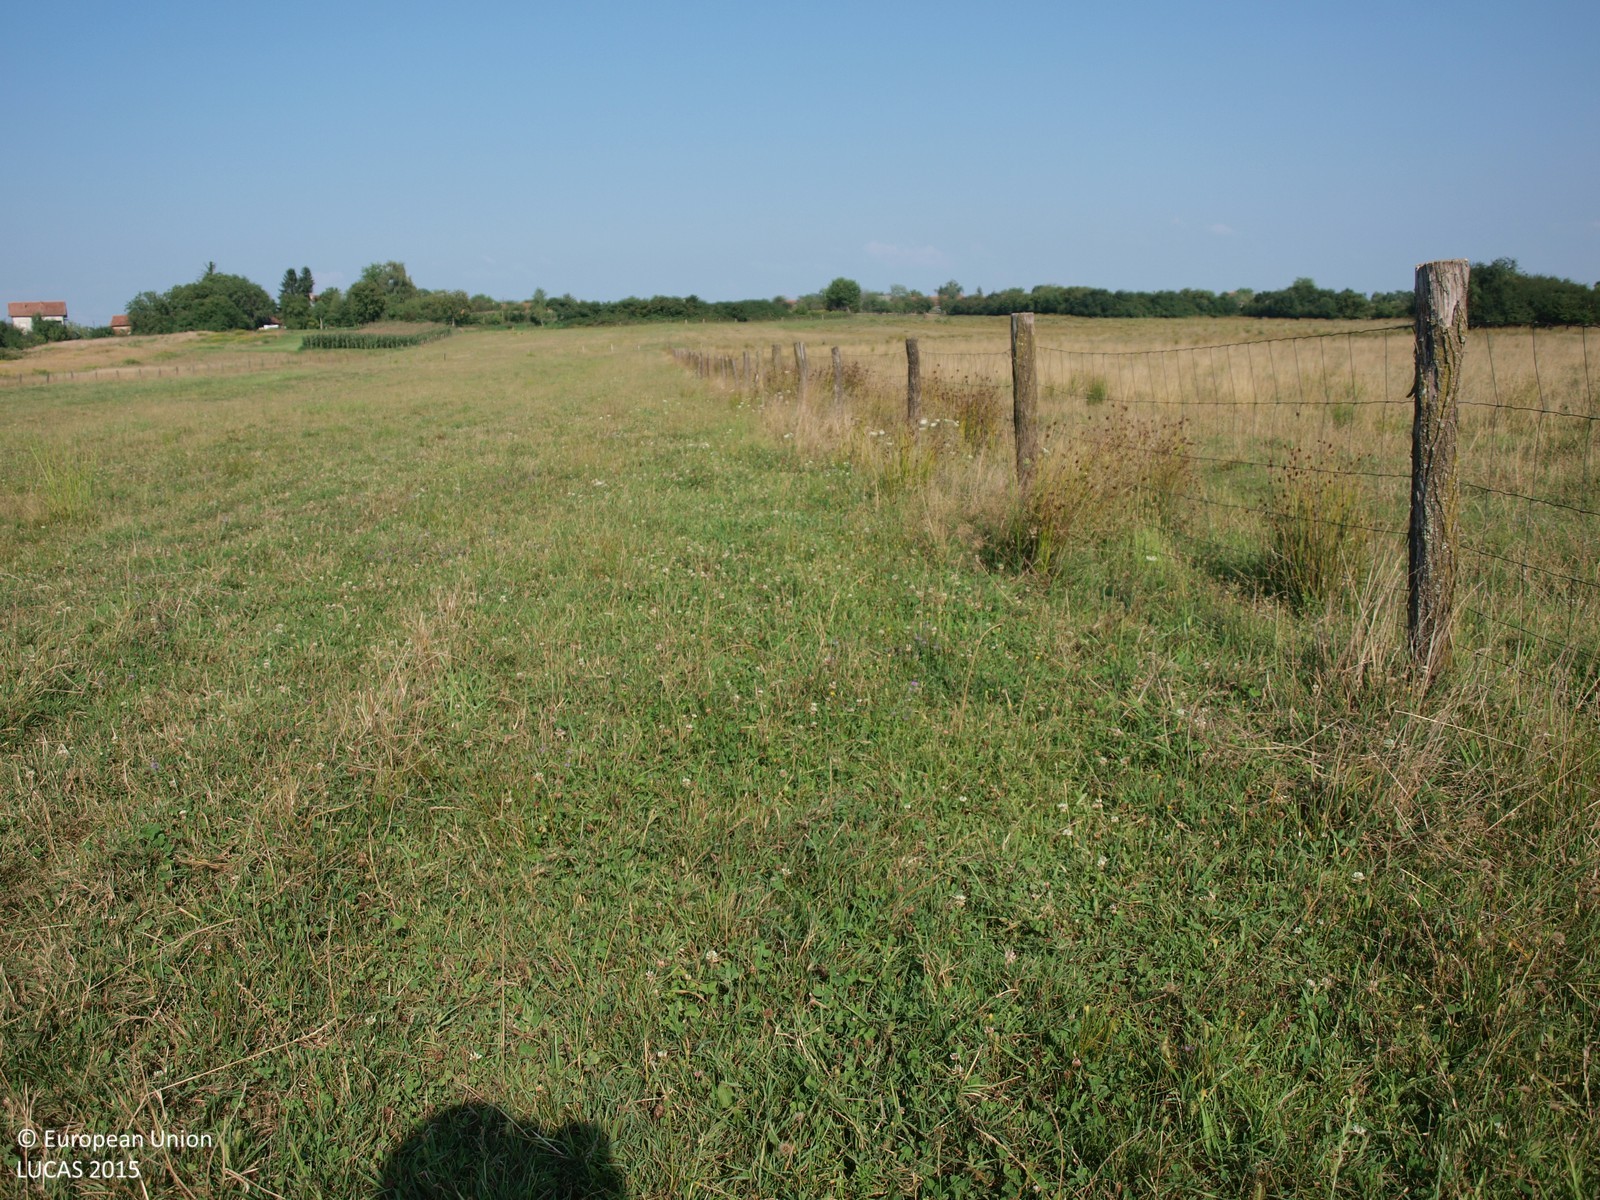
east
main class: Grassland
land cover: Grassland without tree/shrub cover
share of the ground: > 75 %
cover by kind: herbaceous plants 100 %
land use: Agriculture (excluding fallow land and kitchen gardens)
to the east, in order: Grassland without tree/shrub cover; Fences; Grassland without tree/shrub cover; Fences; Grassland without tree/shrub cover
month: August
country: HR
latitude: 45.8446
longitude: 16.5277
